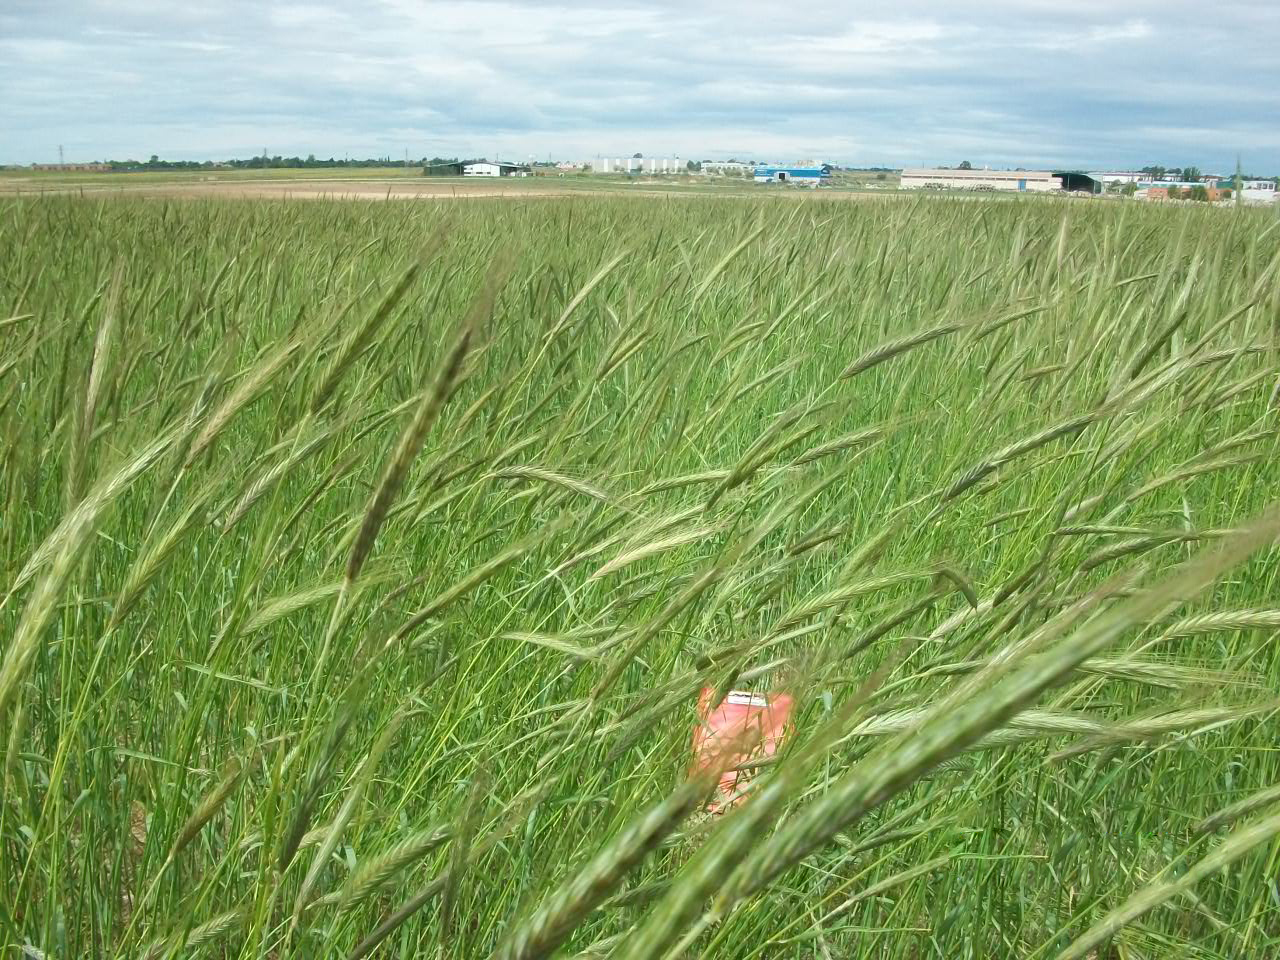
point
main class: Cropland
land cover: Rye
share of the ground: > 75 %
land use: Agriculture (excluding fallow land and kitchen gardens)
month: May
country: ES
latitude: 40.2008
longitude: -3.8163
